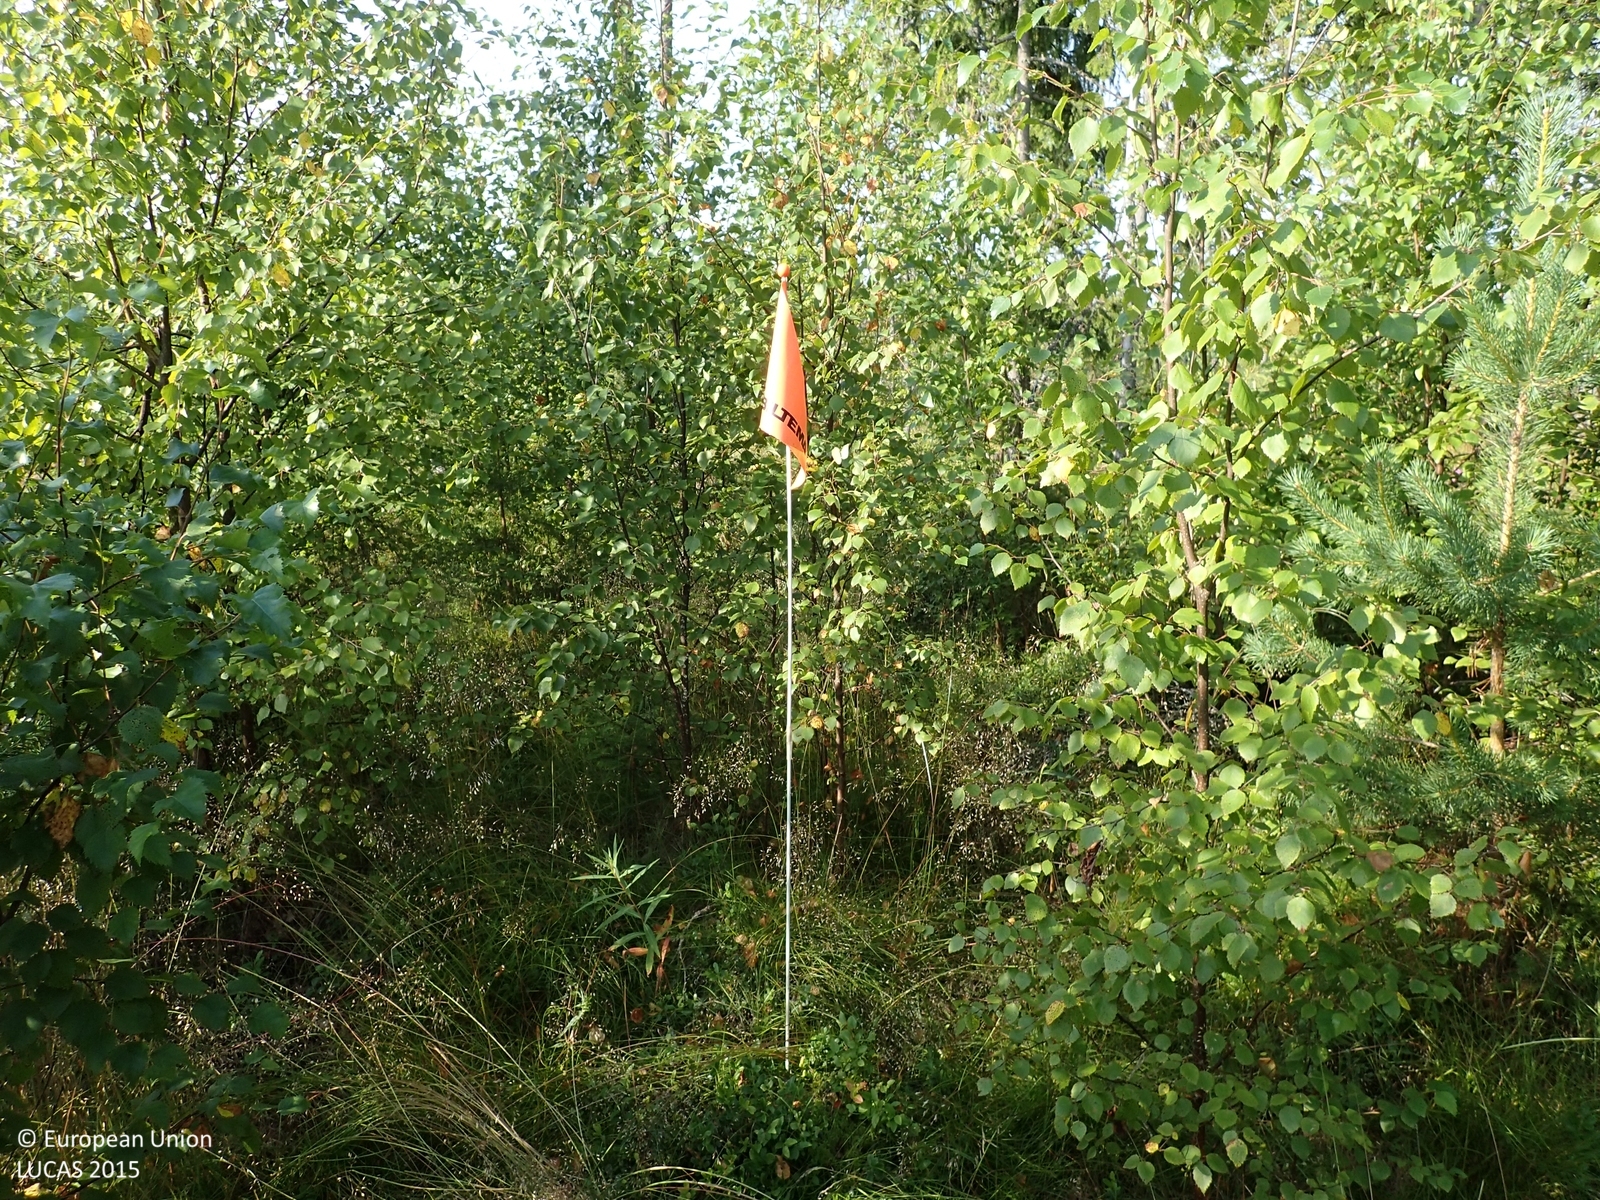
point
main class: Woodland
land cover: Other mixed woodland
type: boreal forest
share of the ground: > 75 %
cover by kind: broadleaved forest trees 55 %, coniferous forest trees 20 %, herbaceous plants 15 %, shrubs 10 %
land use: Forestry
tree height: < 5 m
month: August
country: FI
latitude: 62.6212
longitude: 22.0360
